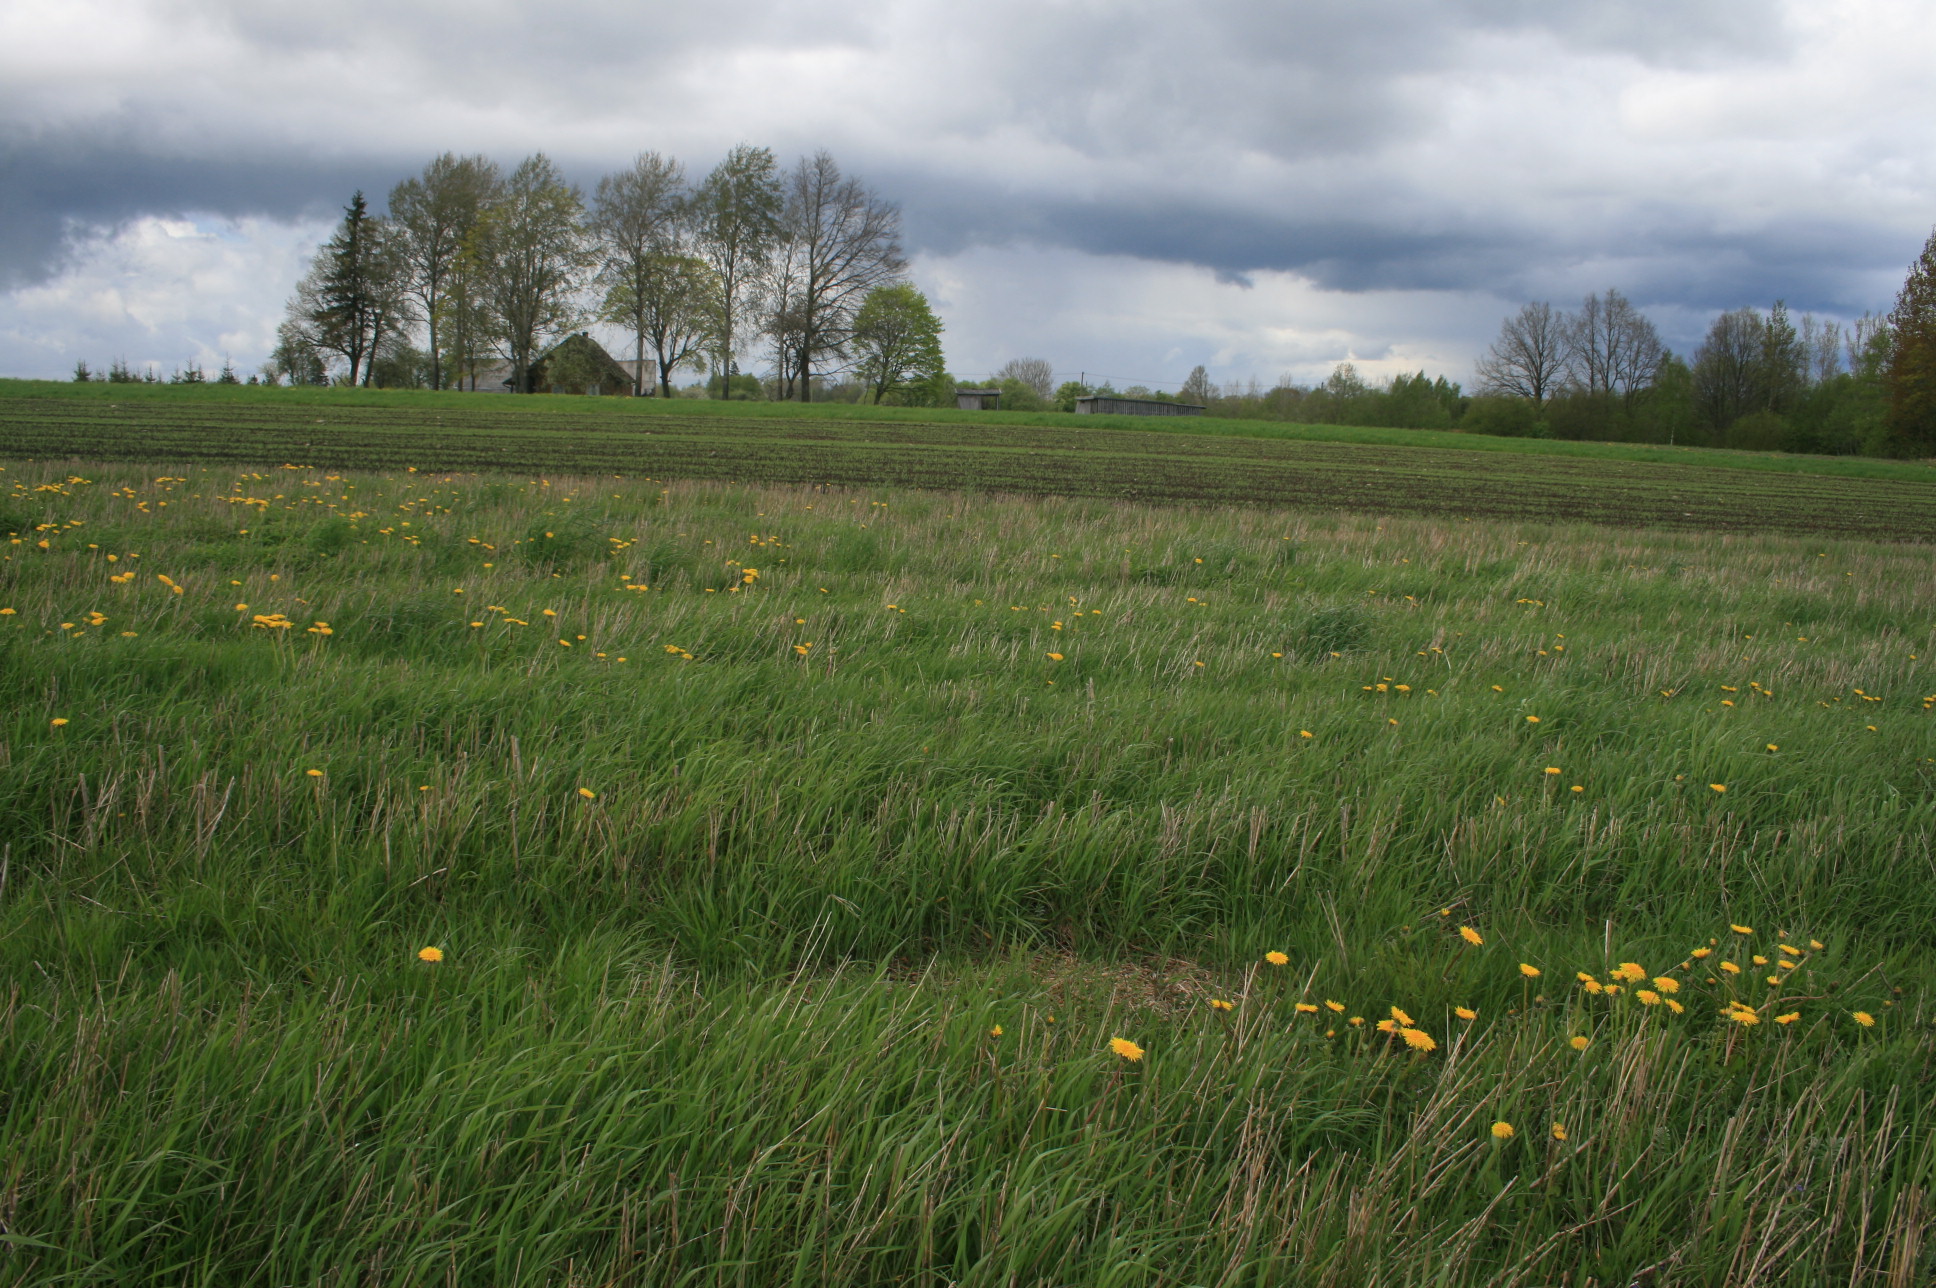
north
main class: Grassland
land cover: Grassland without tree/shrub cover
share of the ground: > 75 %
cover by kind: herbaceous plants 100 %
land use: Agriculture (excluding fallow land and kitchen gardens)
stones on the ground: < 10 %
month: May
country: LT
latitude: 56.2521
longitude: 22.0759
